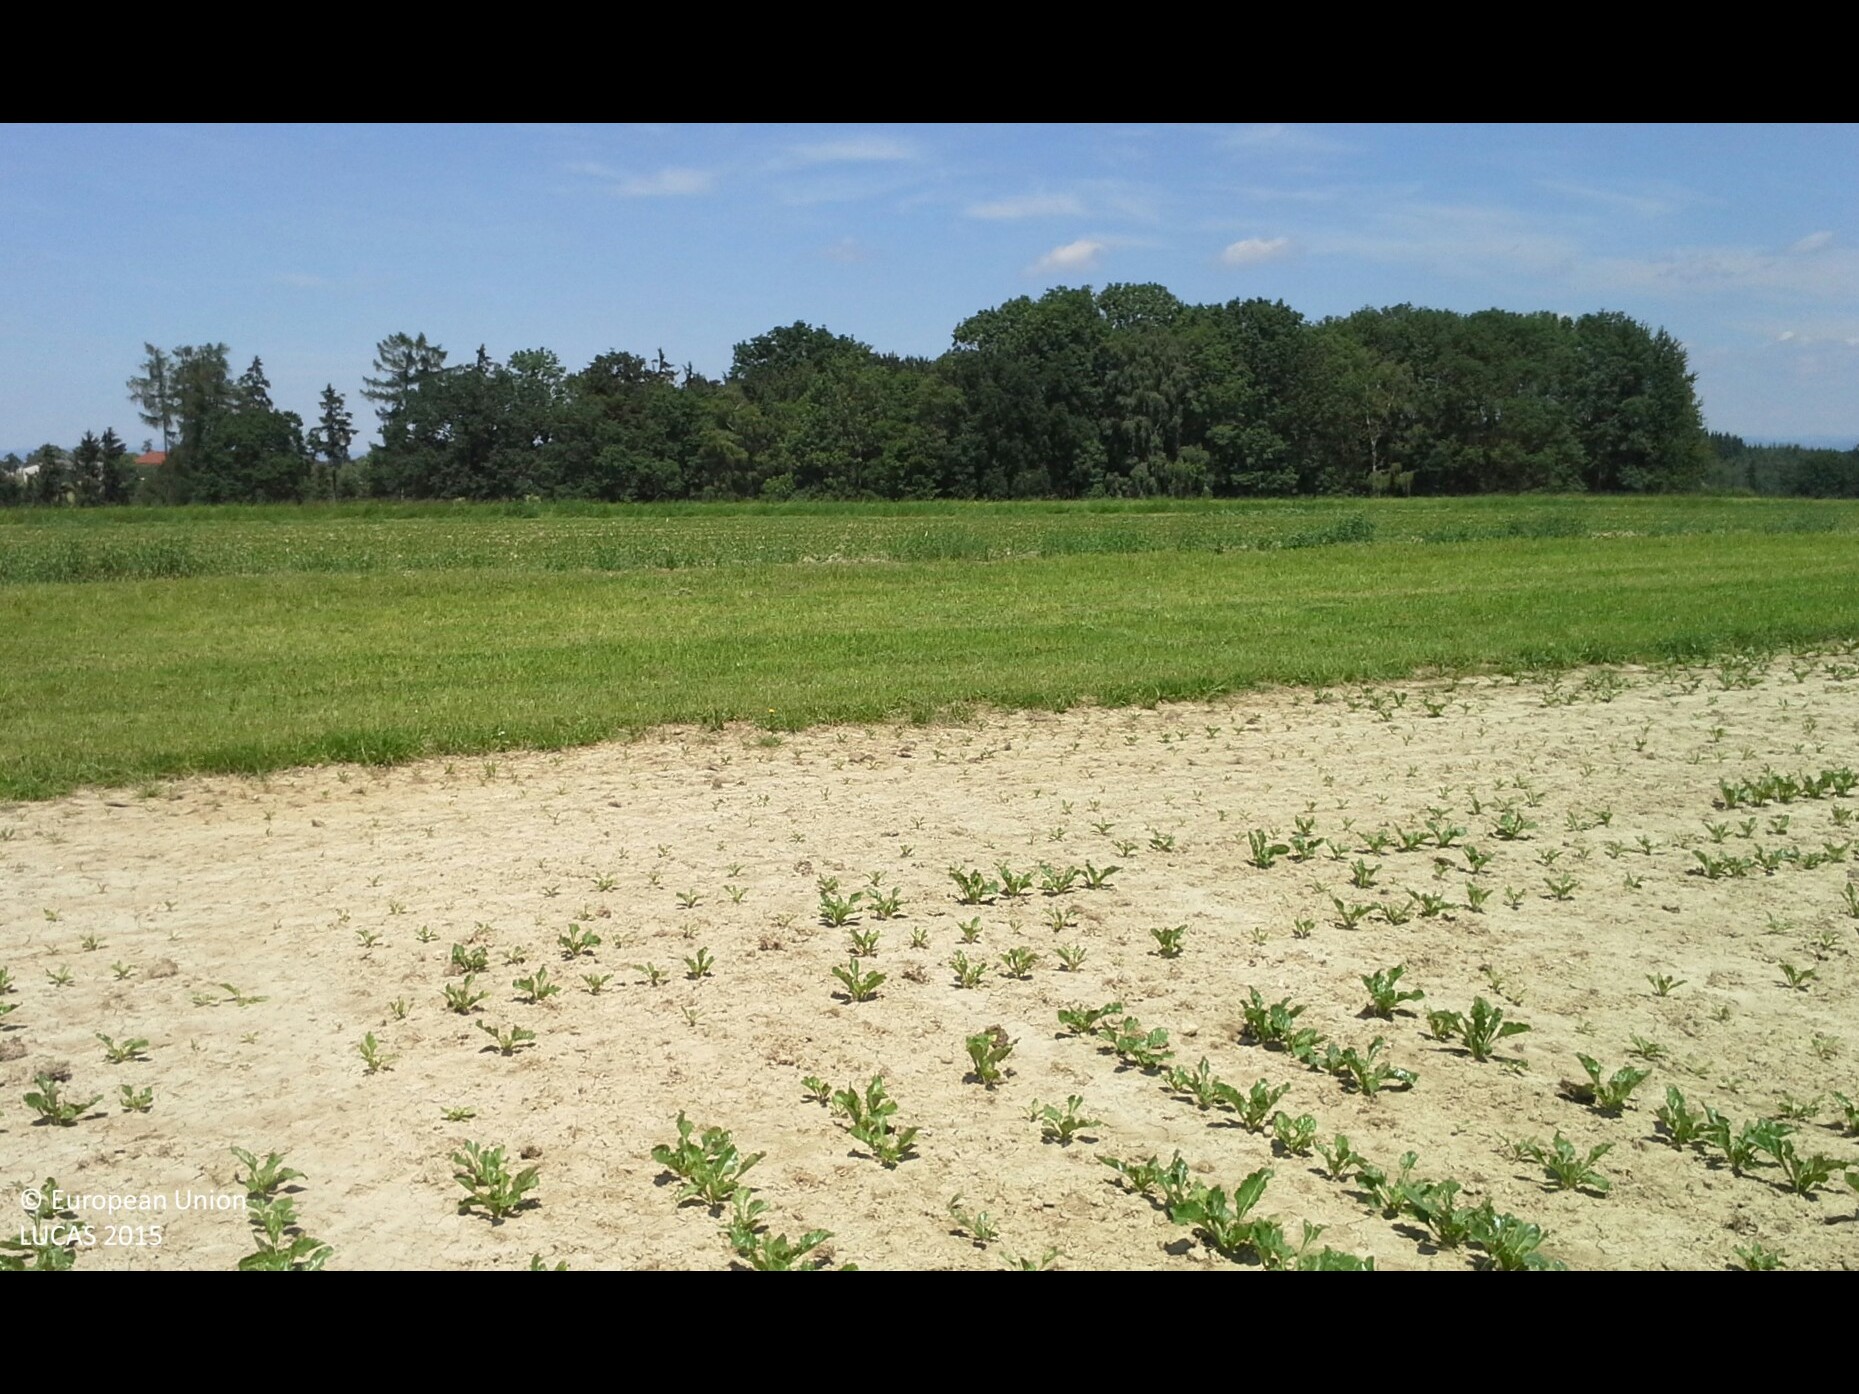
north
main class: Cropland
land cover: Sugar beet
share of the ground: 10 - 25 %
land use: Agriculture (excluding fallow land and kitchen gardens)
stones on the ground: < 10 %
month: June
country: AT
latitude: 48.1317
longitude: 14.5015
